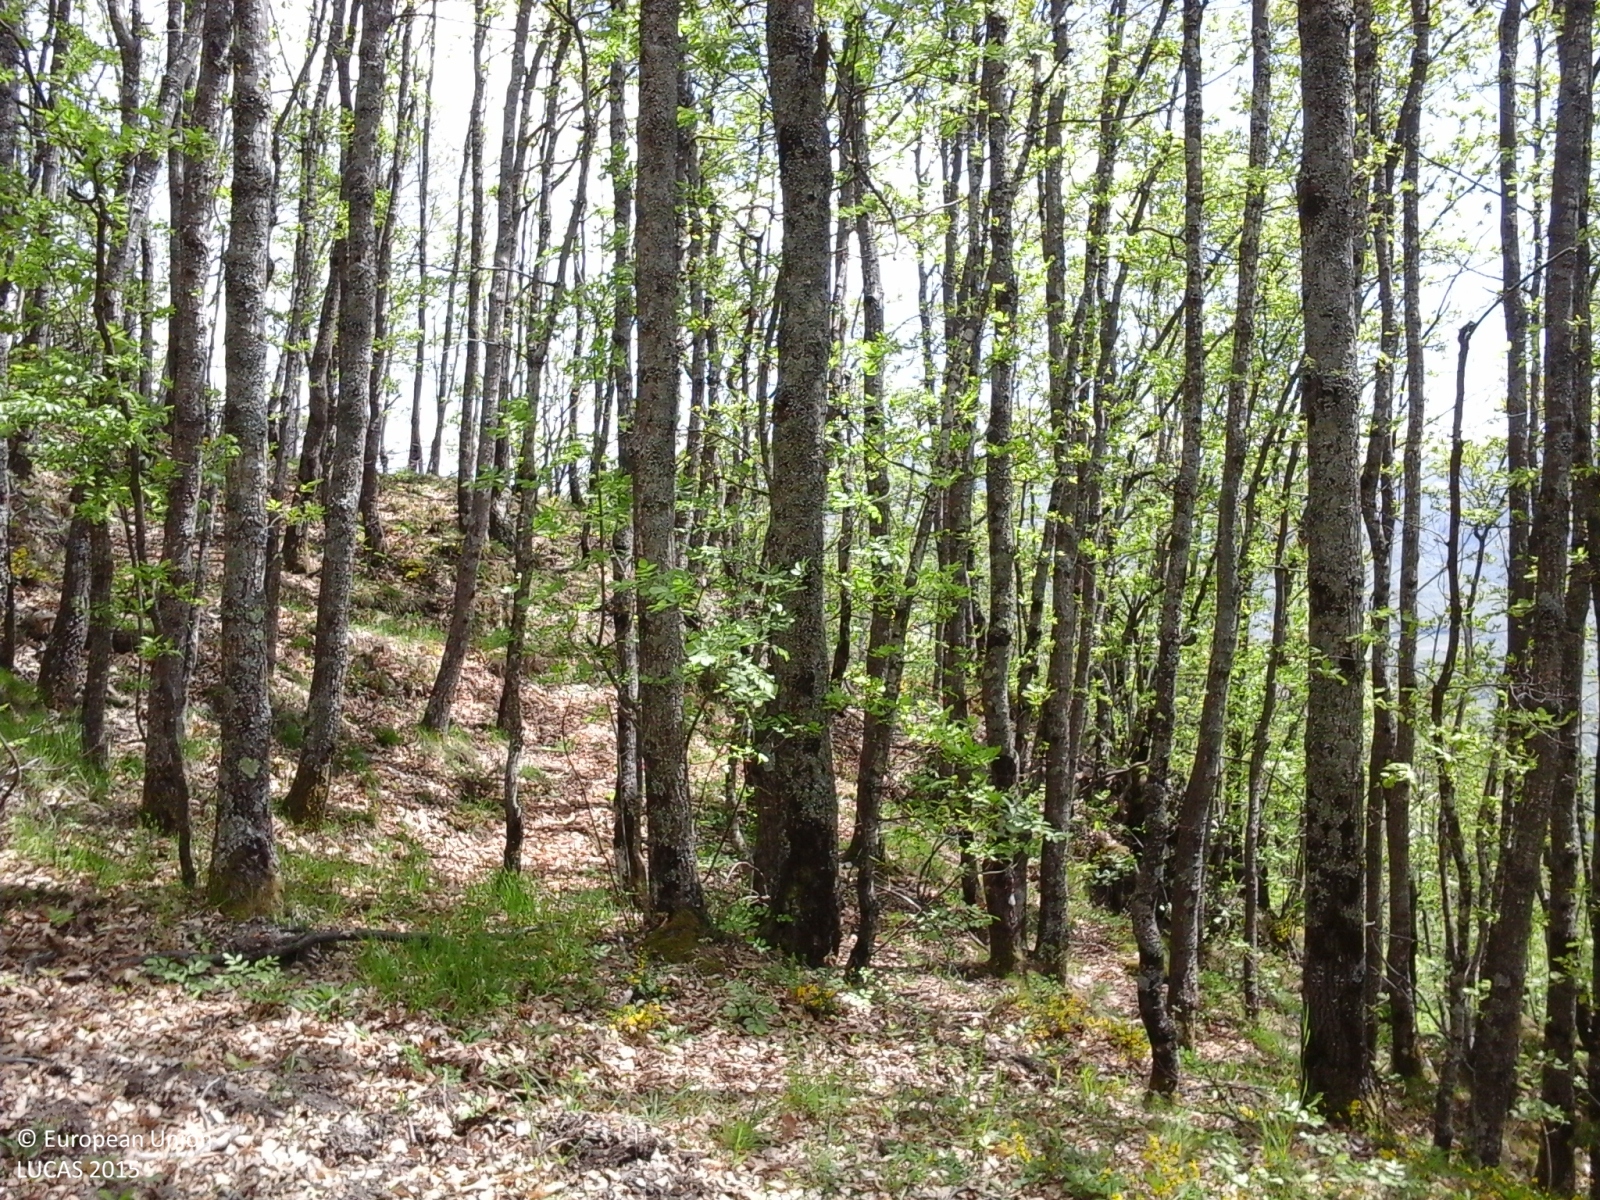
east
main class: Woodland
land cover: Broadleaved woodland
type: mesophytic deciduous forest
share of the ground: > 75 %
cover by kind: broadleaved forest trees 100 %
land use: Forestry
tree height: > 5 m
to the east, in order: Broadleaved woodland; Rivers and streams; Broadleaved woodland; Fences; Rivers and streams; Grassland without tree/shrub cover; Electric lines; Grassland without tree/shrub cover; Electric lines; Grassland without tree/shrub cover; Abandoned hedges; Grassland without tree/shrub cover; Fences; Abandoned hedges; Grass margins; Paved roads, cycling and walking lanes; Fences; Other fruit trees and berries; Fences; Paved roads, cycling and walking lanes
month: May
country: IT
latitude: 44.6188
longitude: 9.3084
